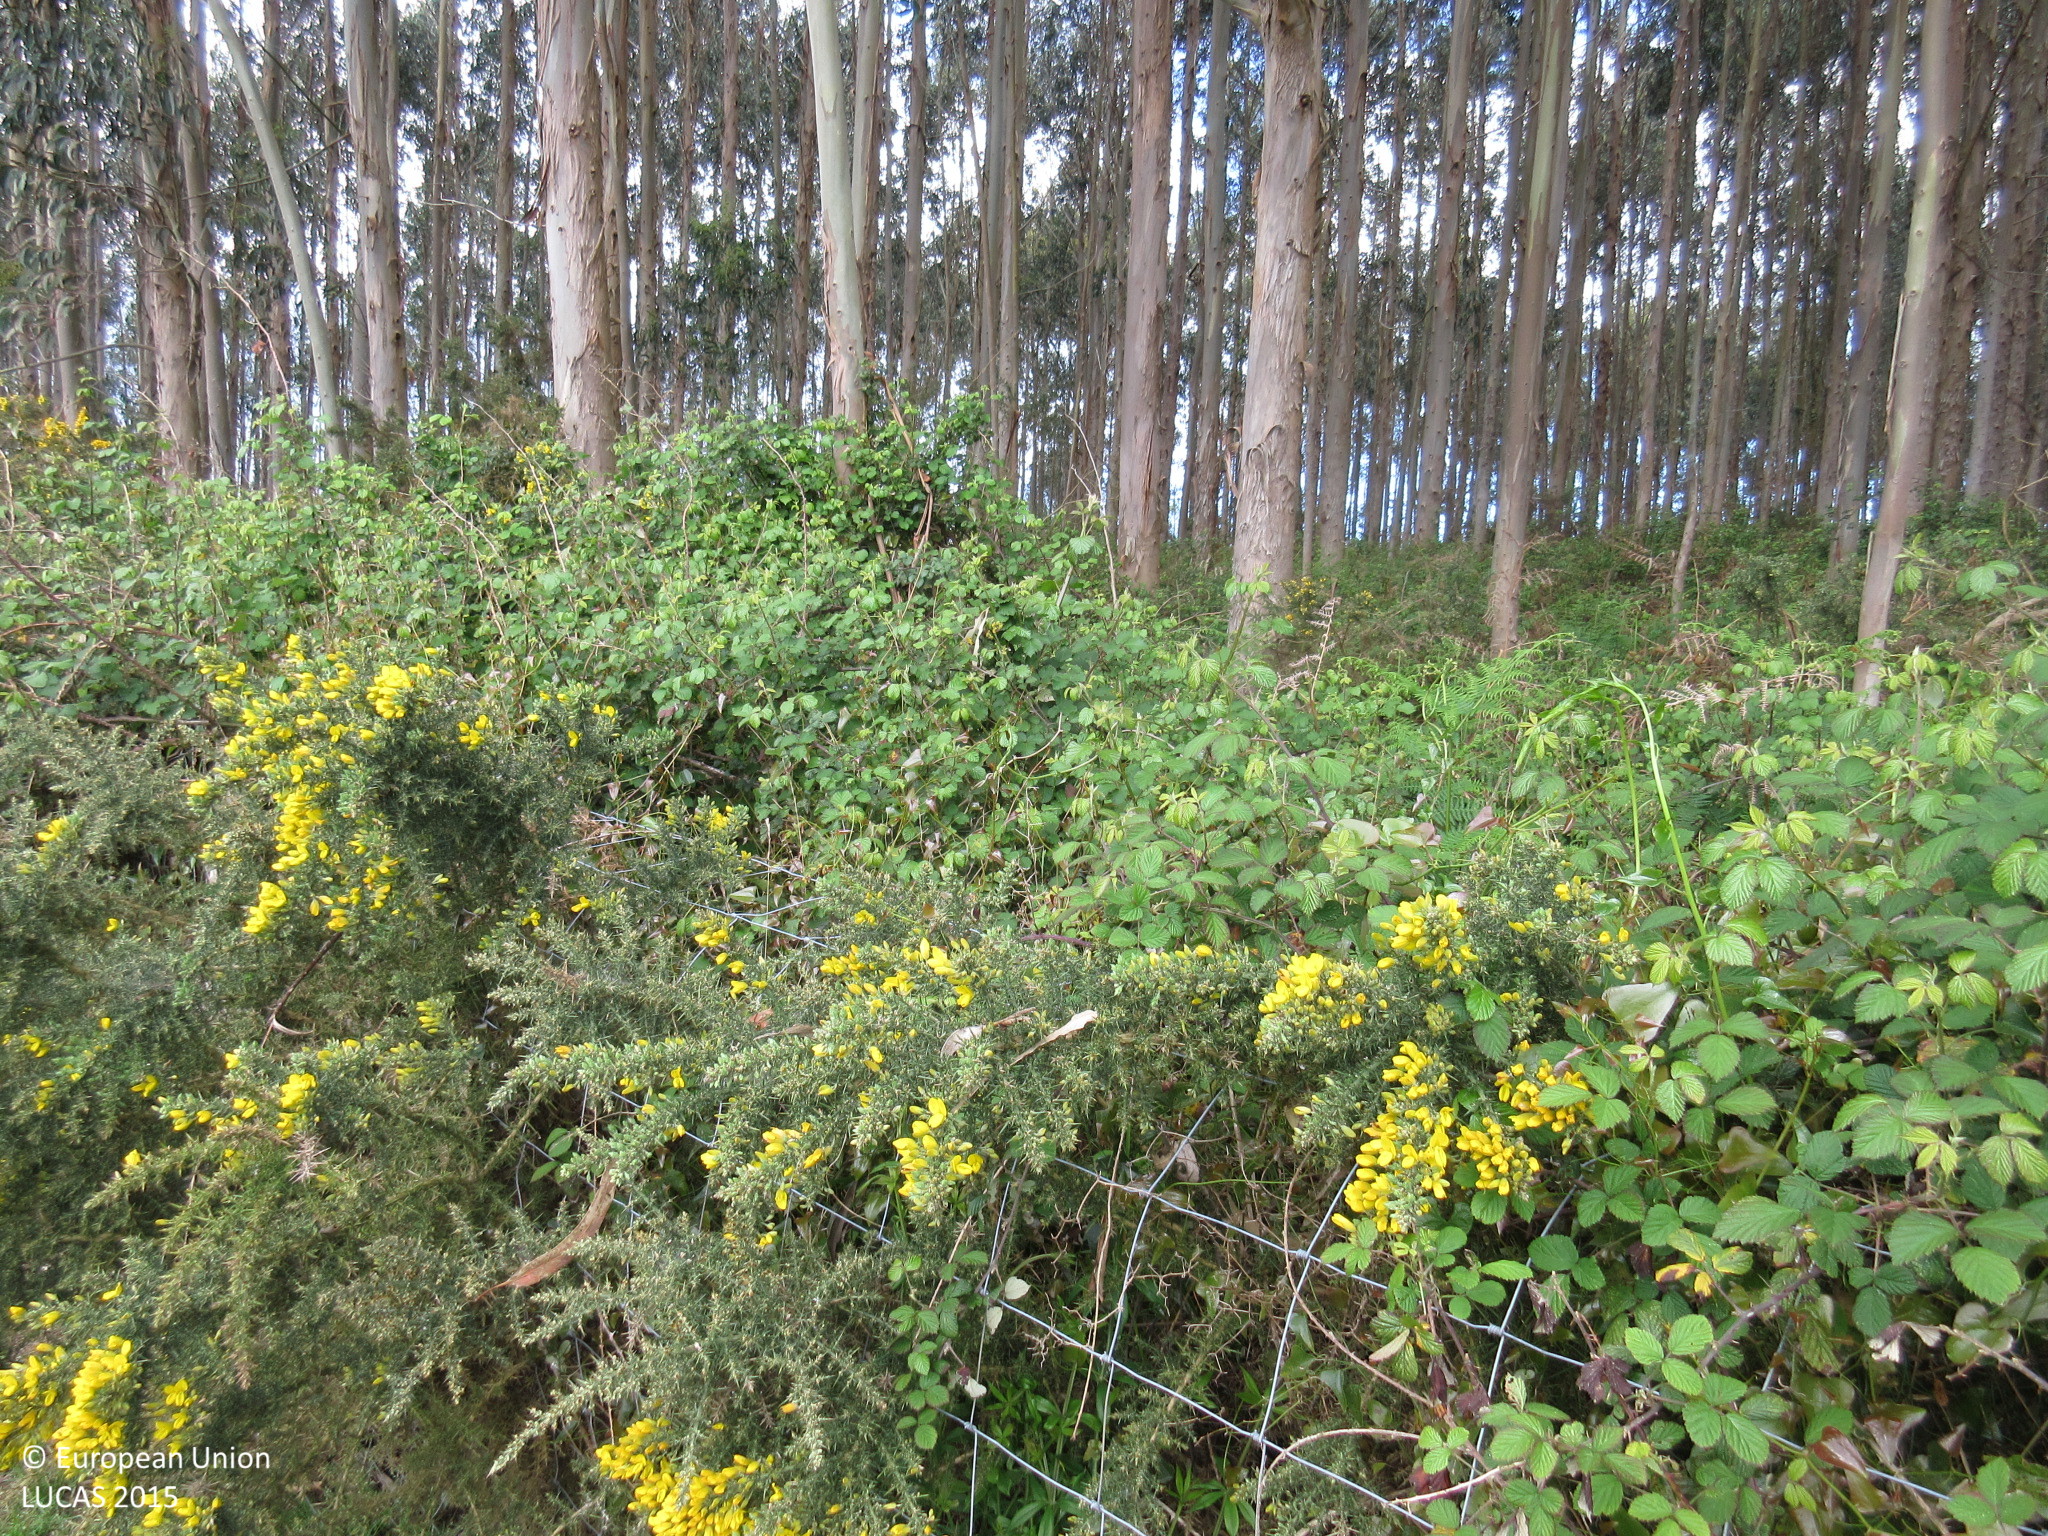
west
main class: Woodland
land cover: Broadleaved woodland
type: exotic forest
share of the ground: > 75 %
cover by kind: broadleaved forest trees 90 %, shrubs 10 %
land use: Forestry
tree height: > 5 m
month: April
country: ES
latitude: 43.4736
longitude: -5.1180
